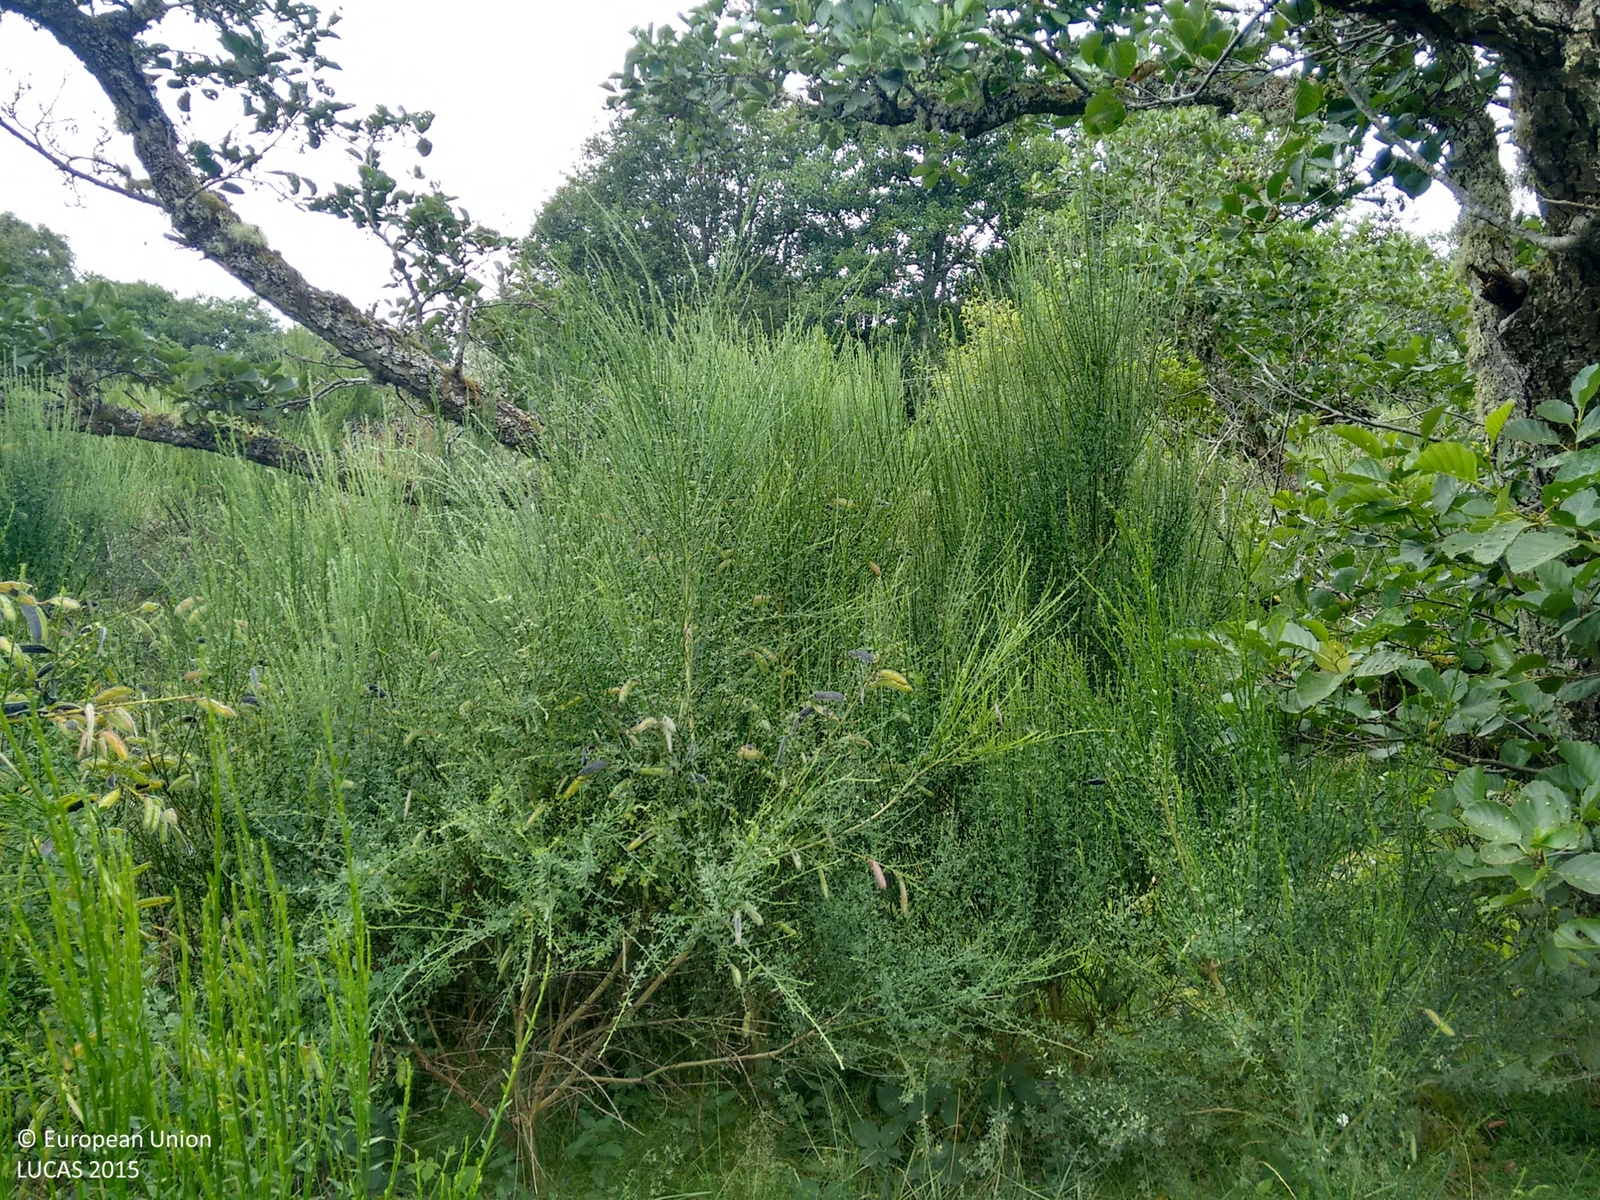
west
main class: Shrubland
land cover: Shrubland with sparse tree cover
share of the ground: > 75 %
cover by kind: shrubs 85 %, herbaceous plants 10 %, coniferous forest trees 5 %
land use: Agriculture (excluding fallow land and kitchen gardens)
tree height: > 5 m
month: August
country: GB
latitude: 57.5363
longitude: -4.5064
